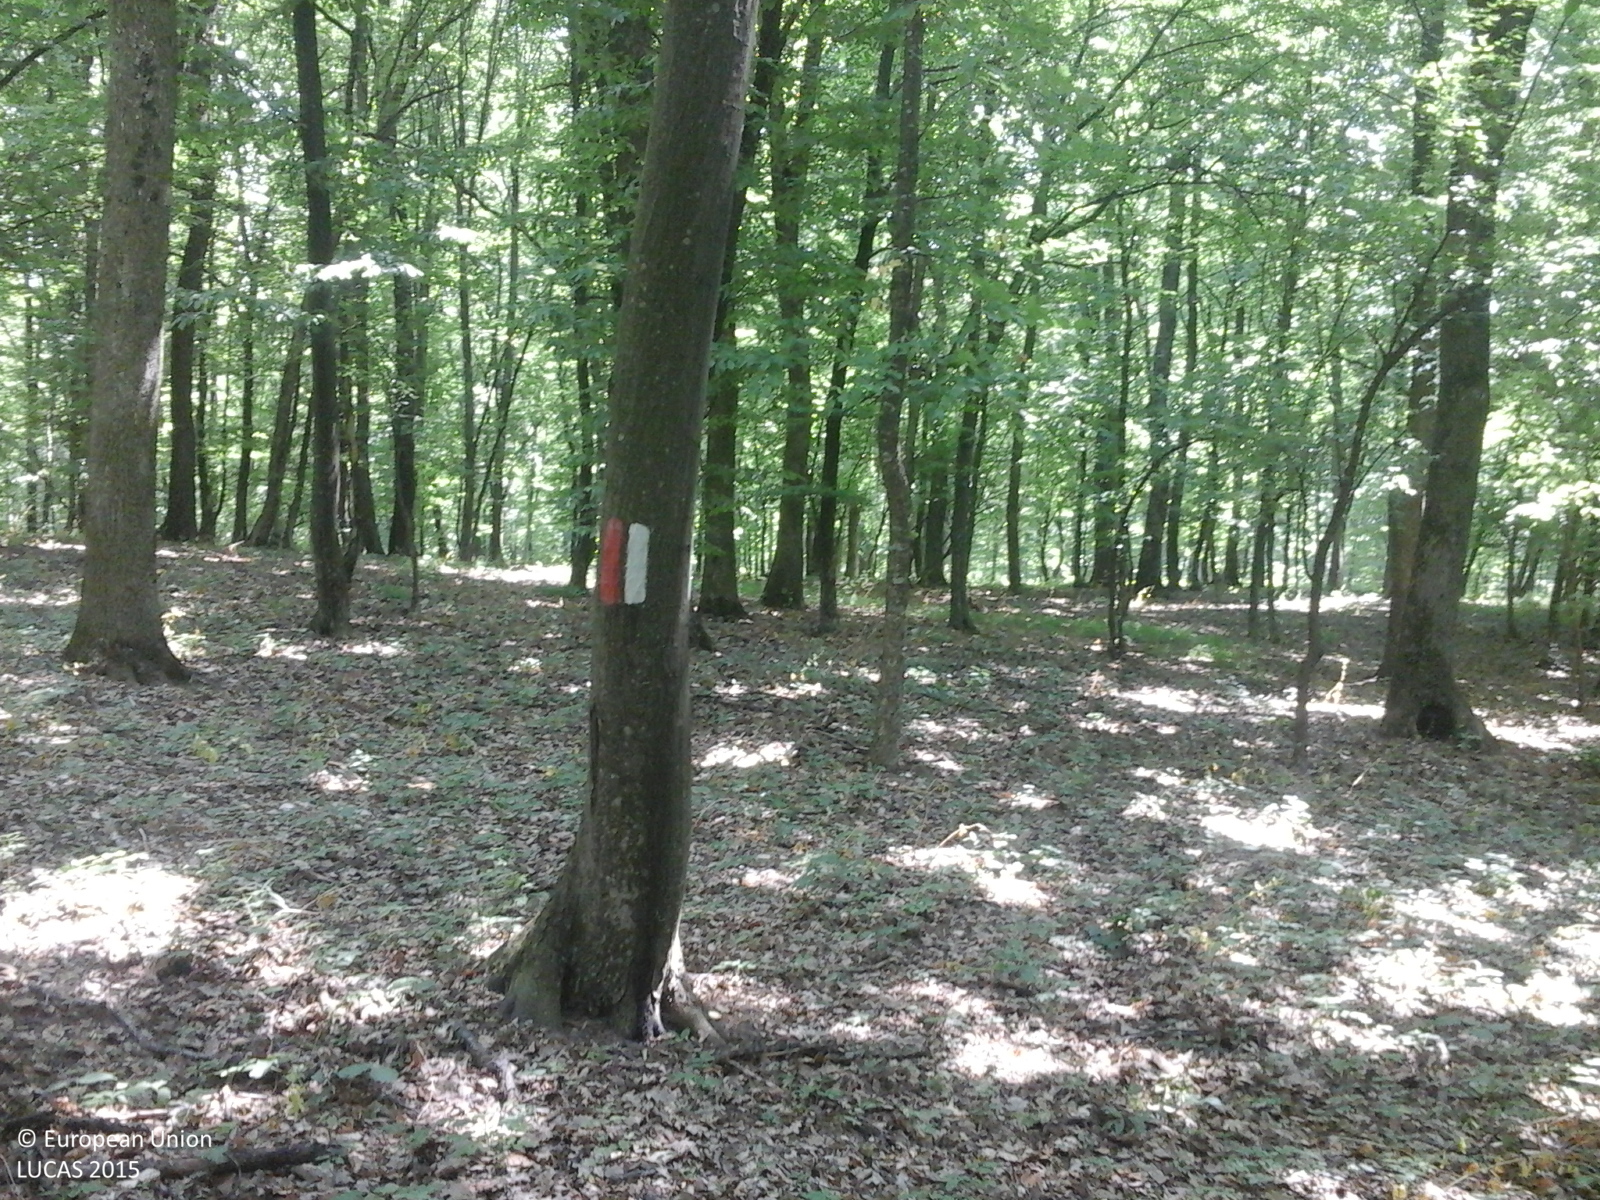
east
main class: Woodland
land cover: Broadleaved woodland
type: mesophytic deciduous forest
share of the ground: > 75 %
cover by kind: broadleaved forest trees 100 %
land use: Forestry
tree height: > 5 m
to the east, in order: Broadleaved woodland; Tracks; Broadleaved woodland; Tracks; Broadleaved woodland
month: June
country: RO
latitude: 46.3707
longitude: 27.1413
